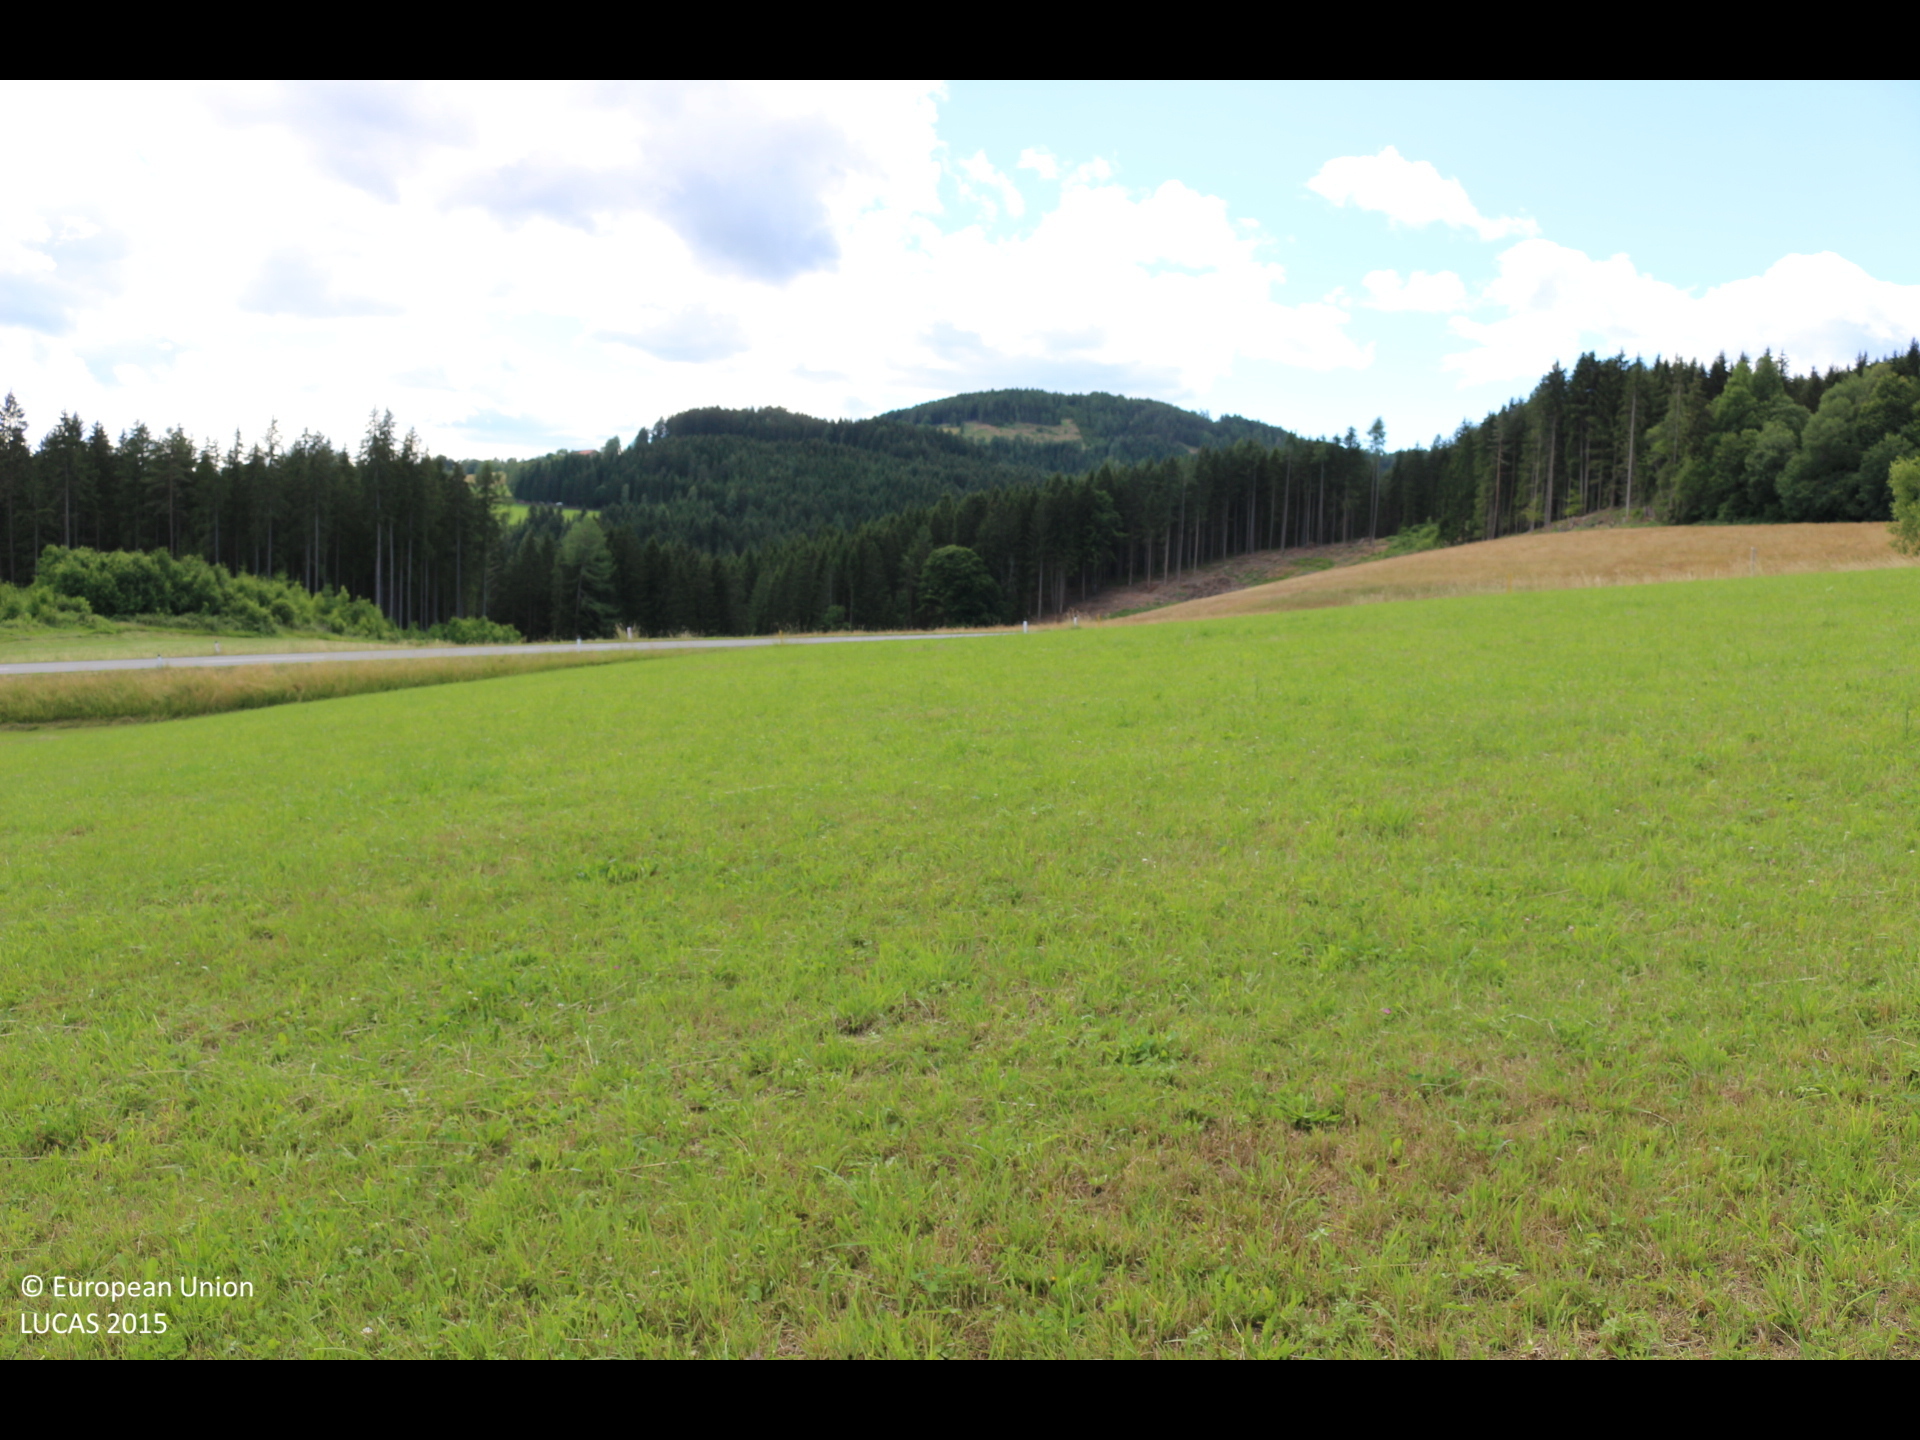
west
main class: Grassland
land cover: Grassland without tree/shrub cover
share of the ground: > 75 %
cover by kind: herbaceous plants 100 %
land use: Agriculture (excluding fallow land and kitchen gardens)
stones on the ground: < 10 %
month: June
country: AT
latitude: 46.8424
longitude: 14.2857
